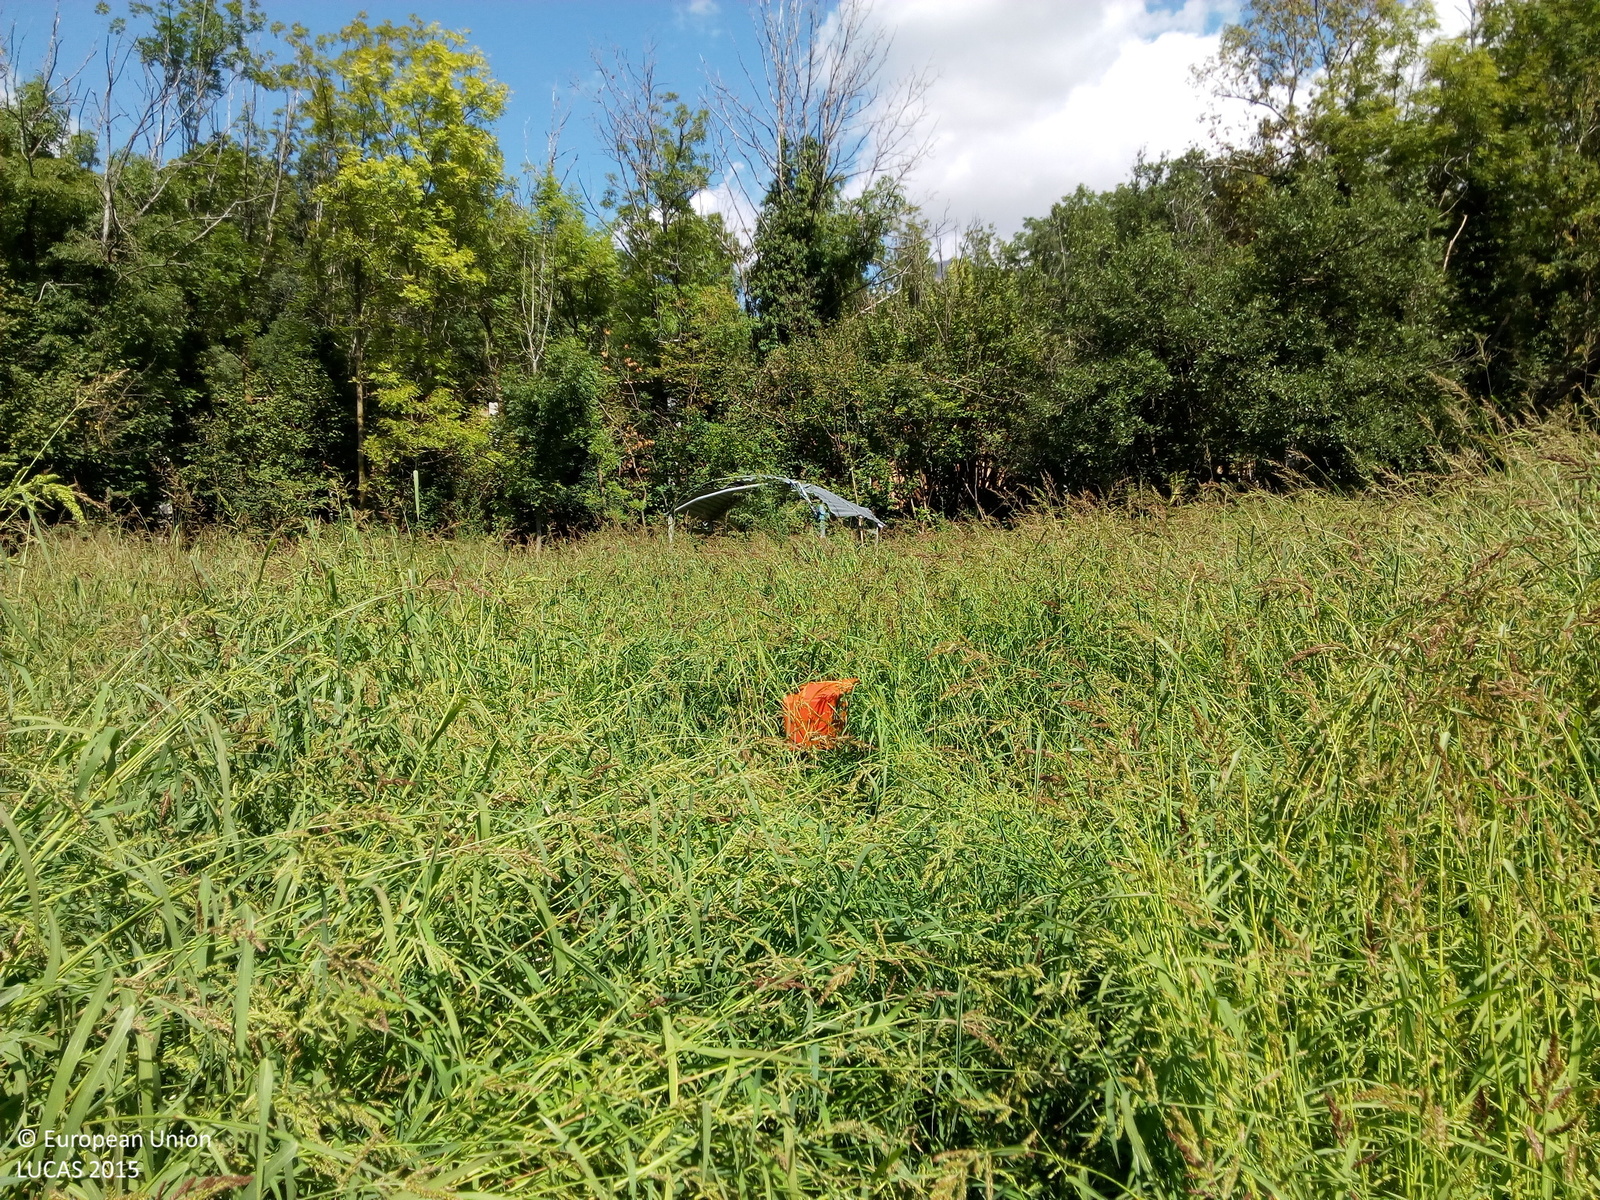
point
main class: Cropland
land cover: Other cereals
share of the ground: > 75 %
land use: Agriculture (excluding fallow land and kitchen gardens)
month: September
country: ES
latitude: 42.5154
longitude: 0.4986
